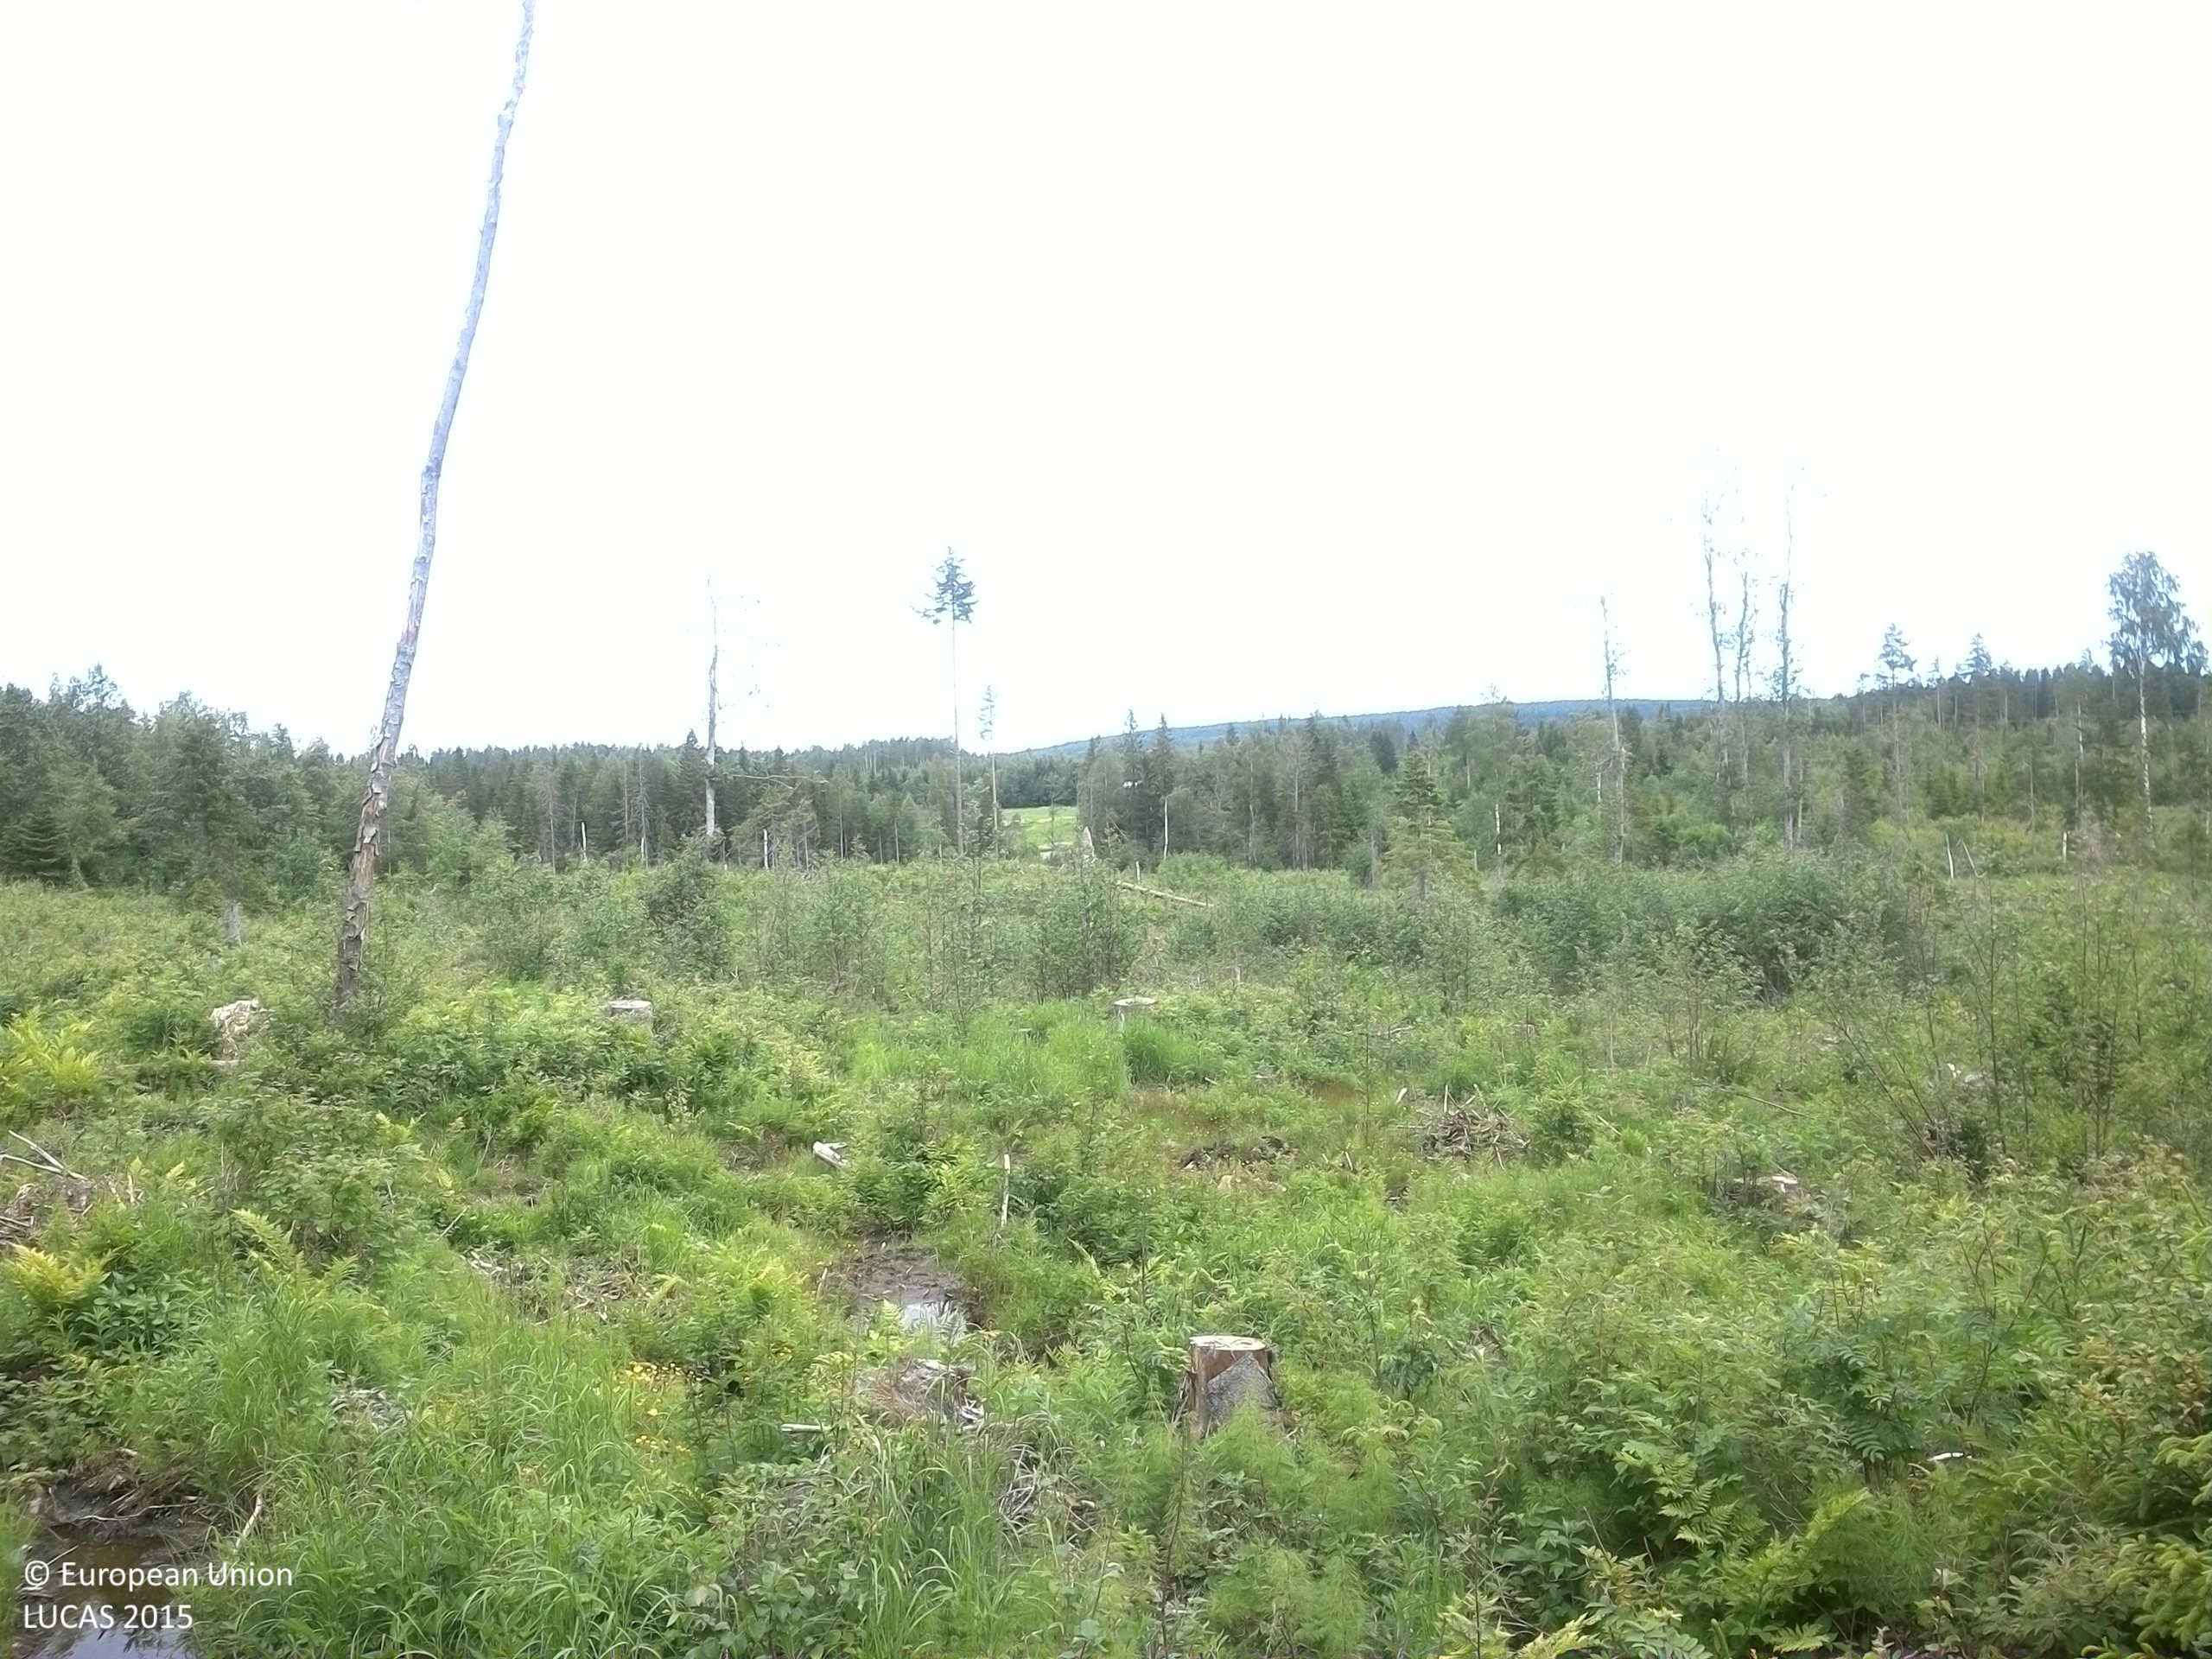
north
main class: Woodland
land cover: Broadleaved woodland
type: boreal forest
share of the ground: 10 - 25 %
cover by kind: shrubs 40 %, broadleaved forest trees 25 %, herbaceous plants 25 %, unconsolidated bare surface 10 %
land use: Forestry
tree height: < 5 m
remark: Clear cut
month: July
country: SE
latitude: 62.6555
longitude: 17.6095
